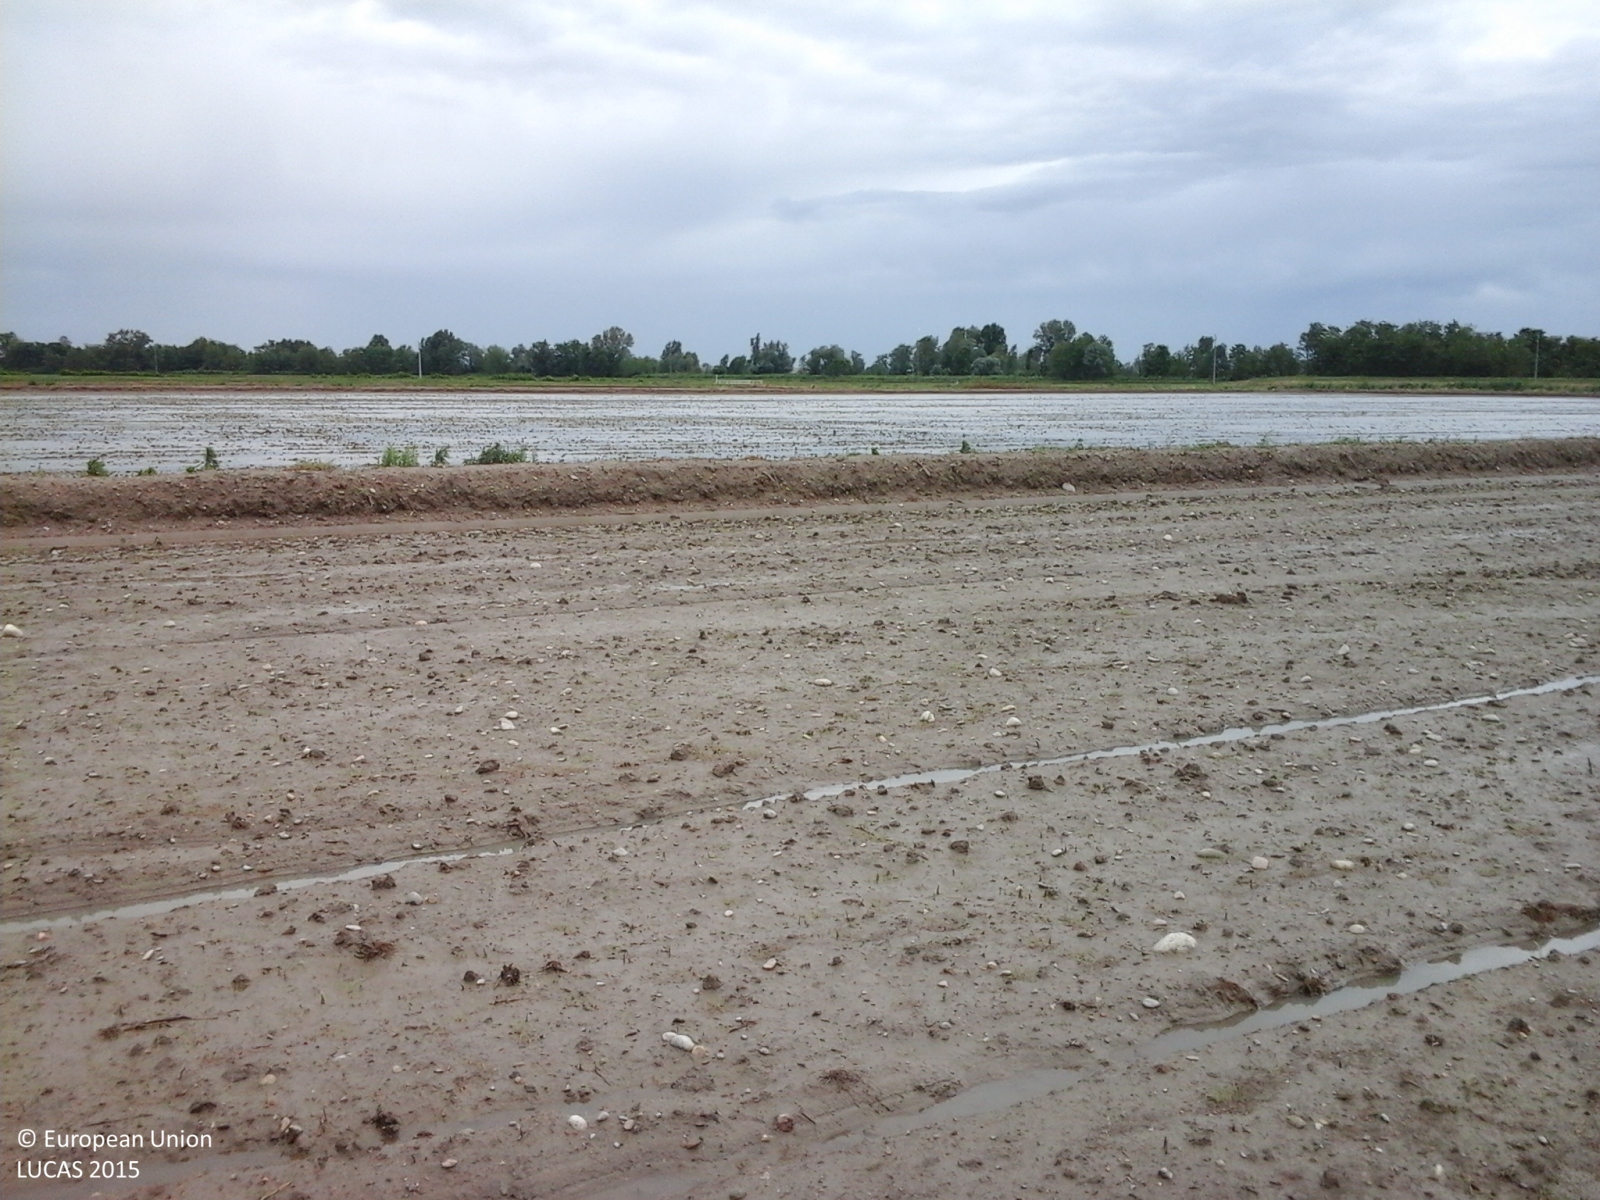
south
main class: Cropland
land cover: Rice
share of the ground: < 10 %
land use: Agriculture (excluding fallow land and kitchen gardens)
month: May
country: IT
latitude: 45.3838
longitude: 8.3808
